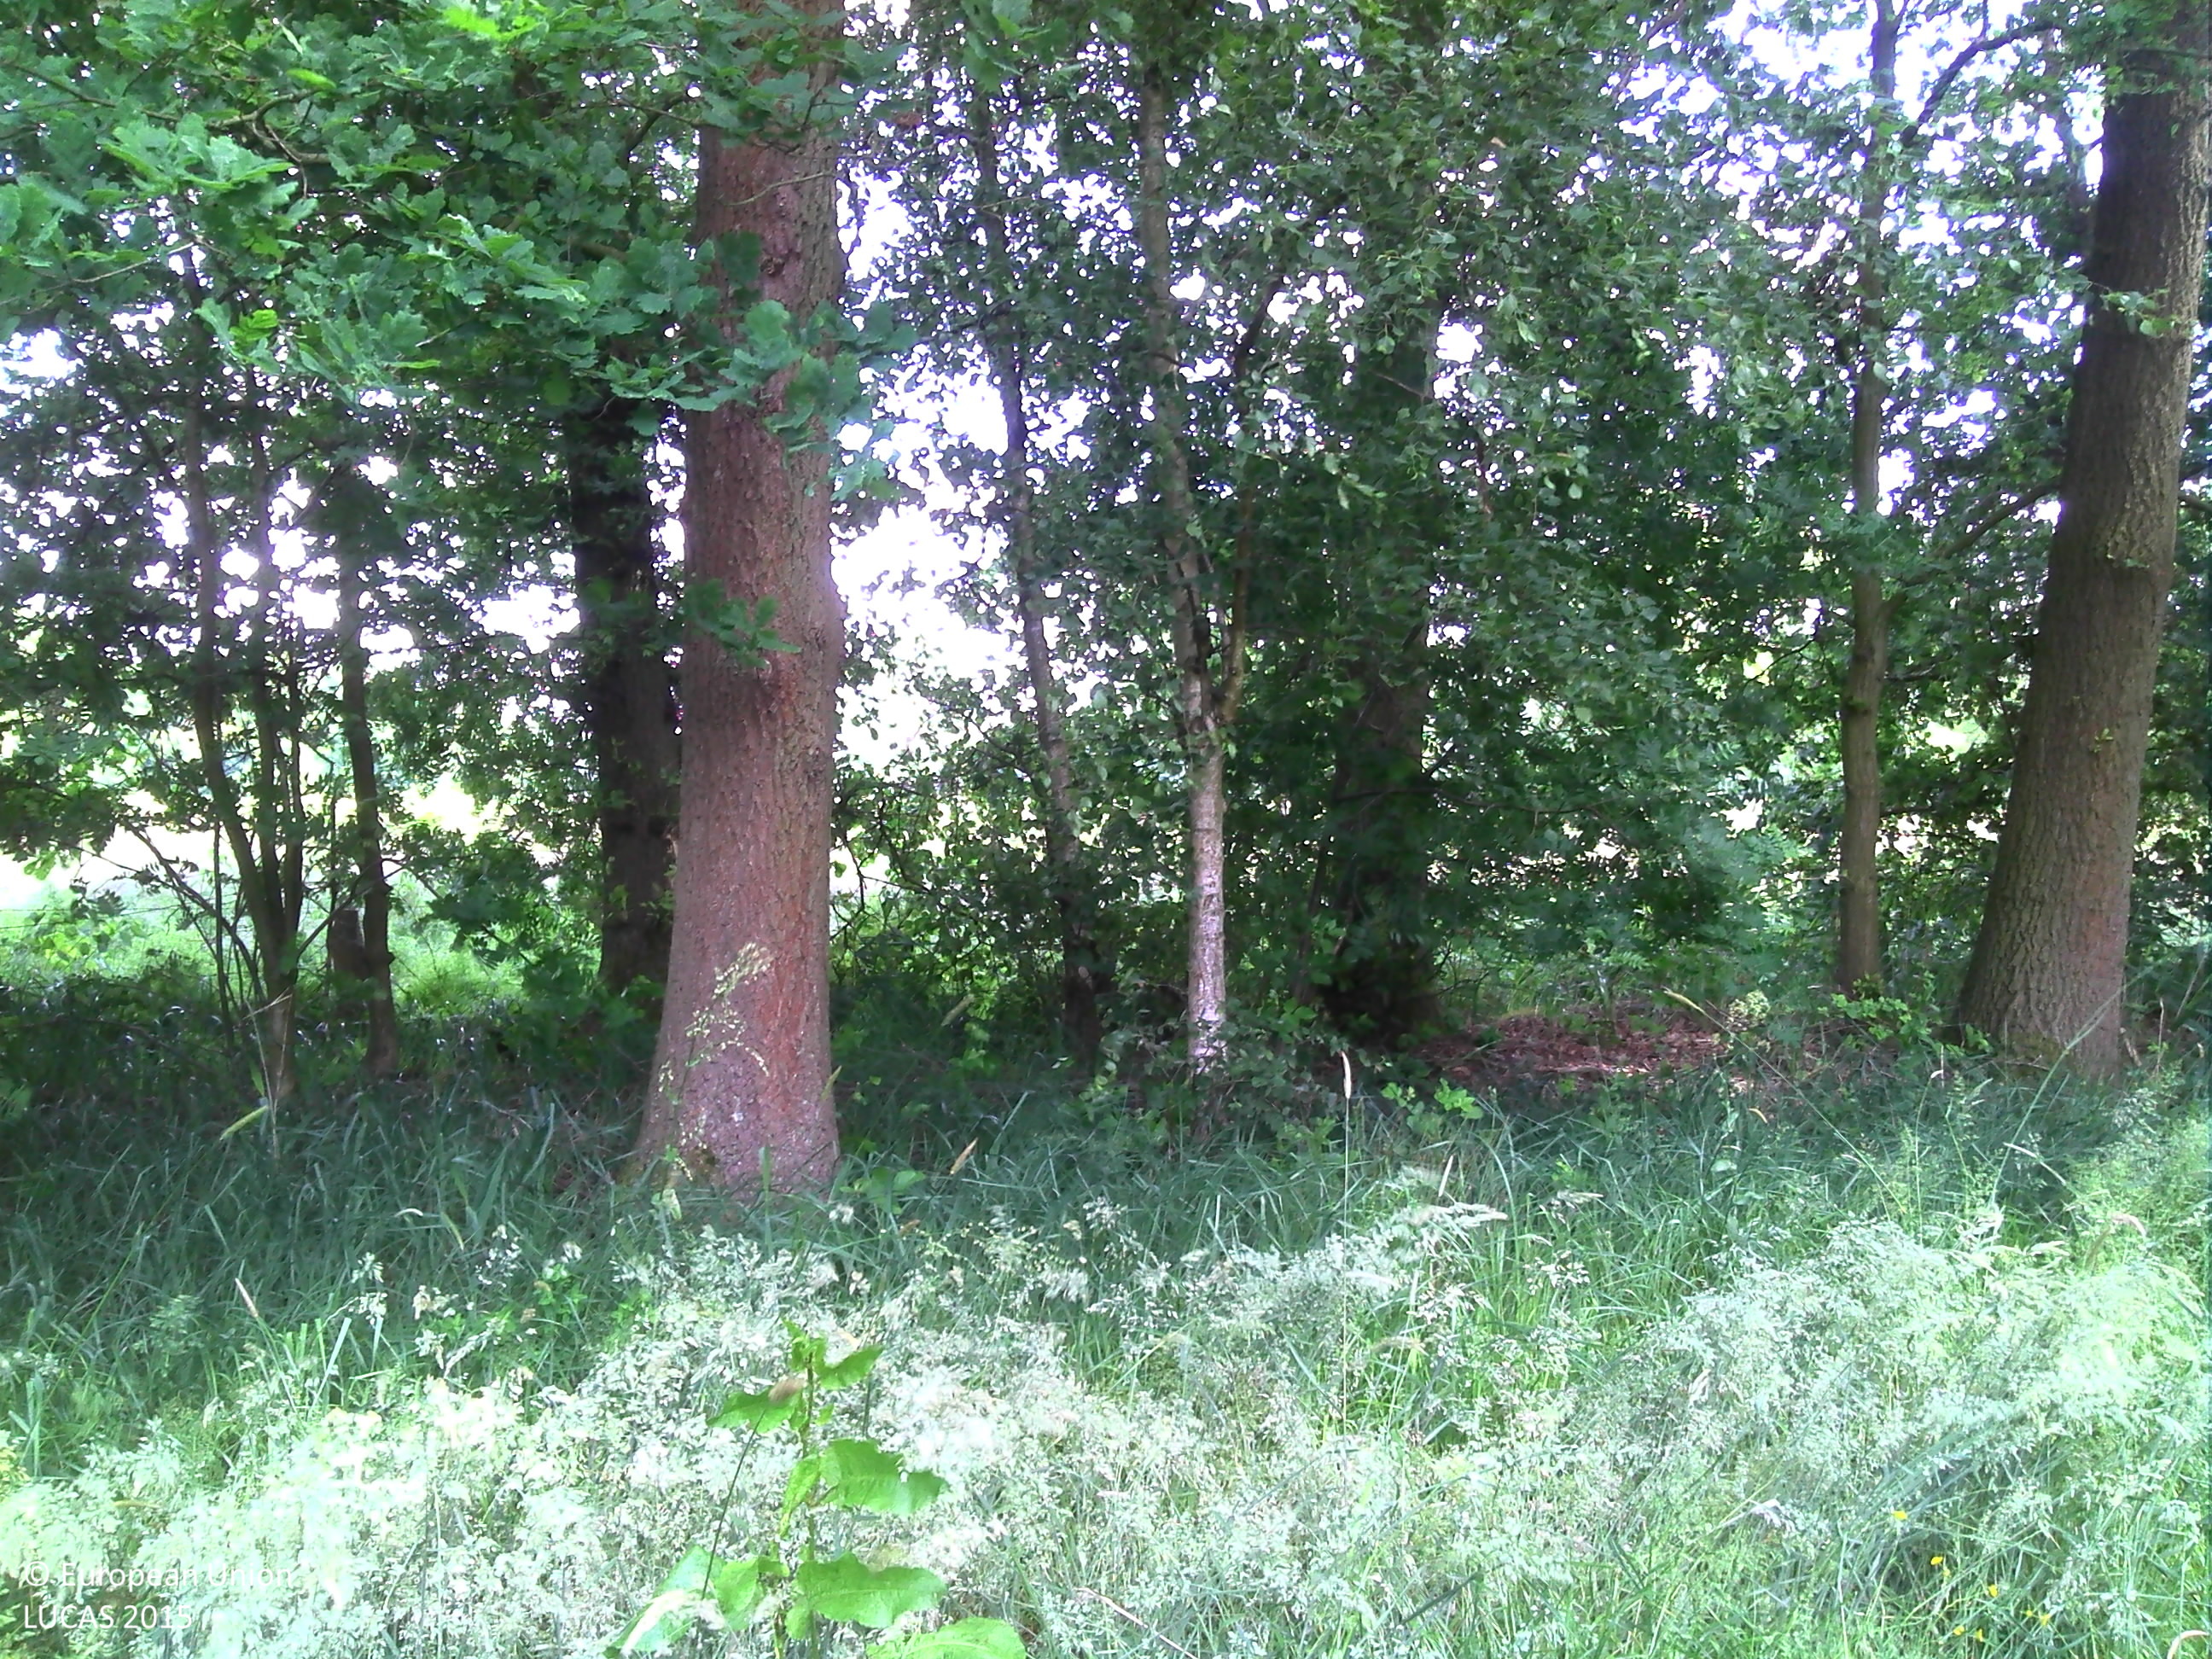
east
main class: Grassland
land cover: Grassland without tree/shrub cover
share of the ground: > 75 %
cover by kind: herbaceous plants 100 %
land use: Agriculture (excluding fallow land and kitchen gardens)
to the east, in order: Grassland without tree/shrub cover; Broadleaved woodland; Fences; Ditches and canals; Fences; Grassland without tree/shrub cover; Fences; Grass margins; Tracks; Grass margins; Maize
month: June
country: BE
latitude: 51.0946
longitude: 5.7292
